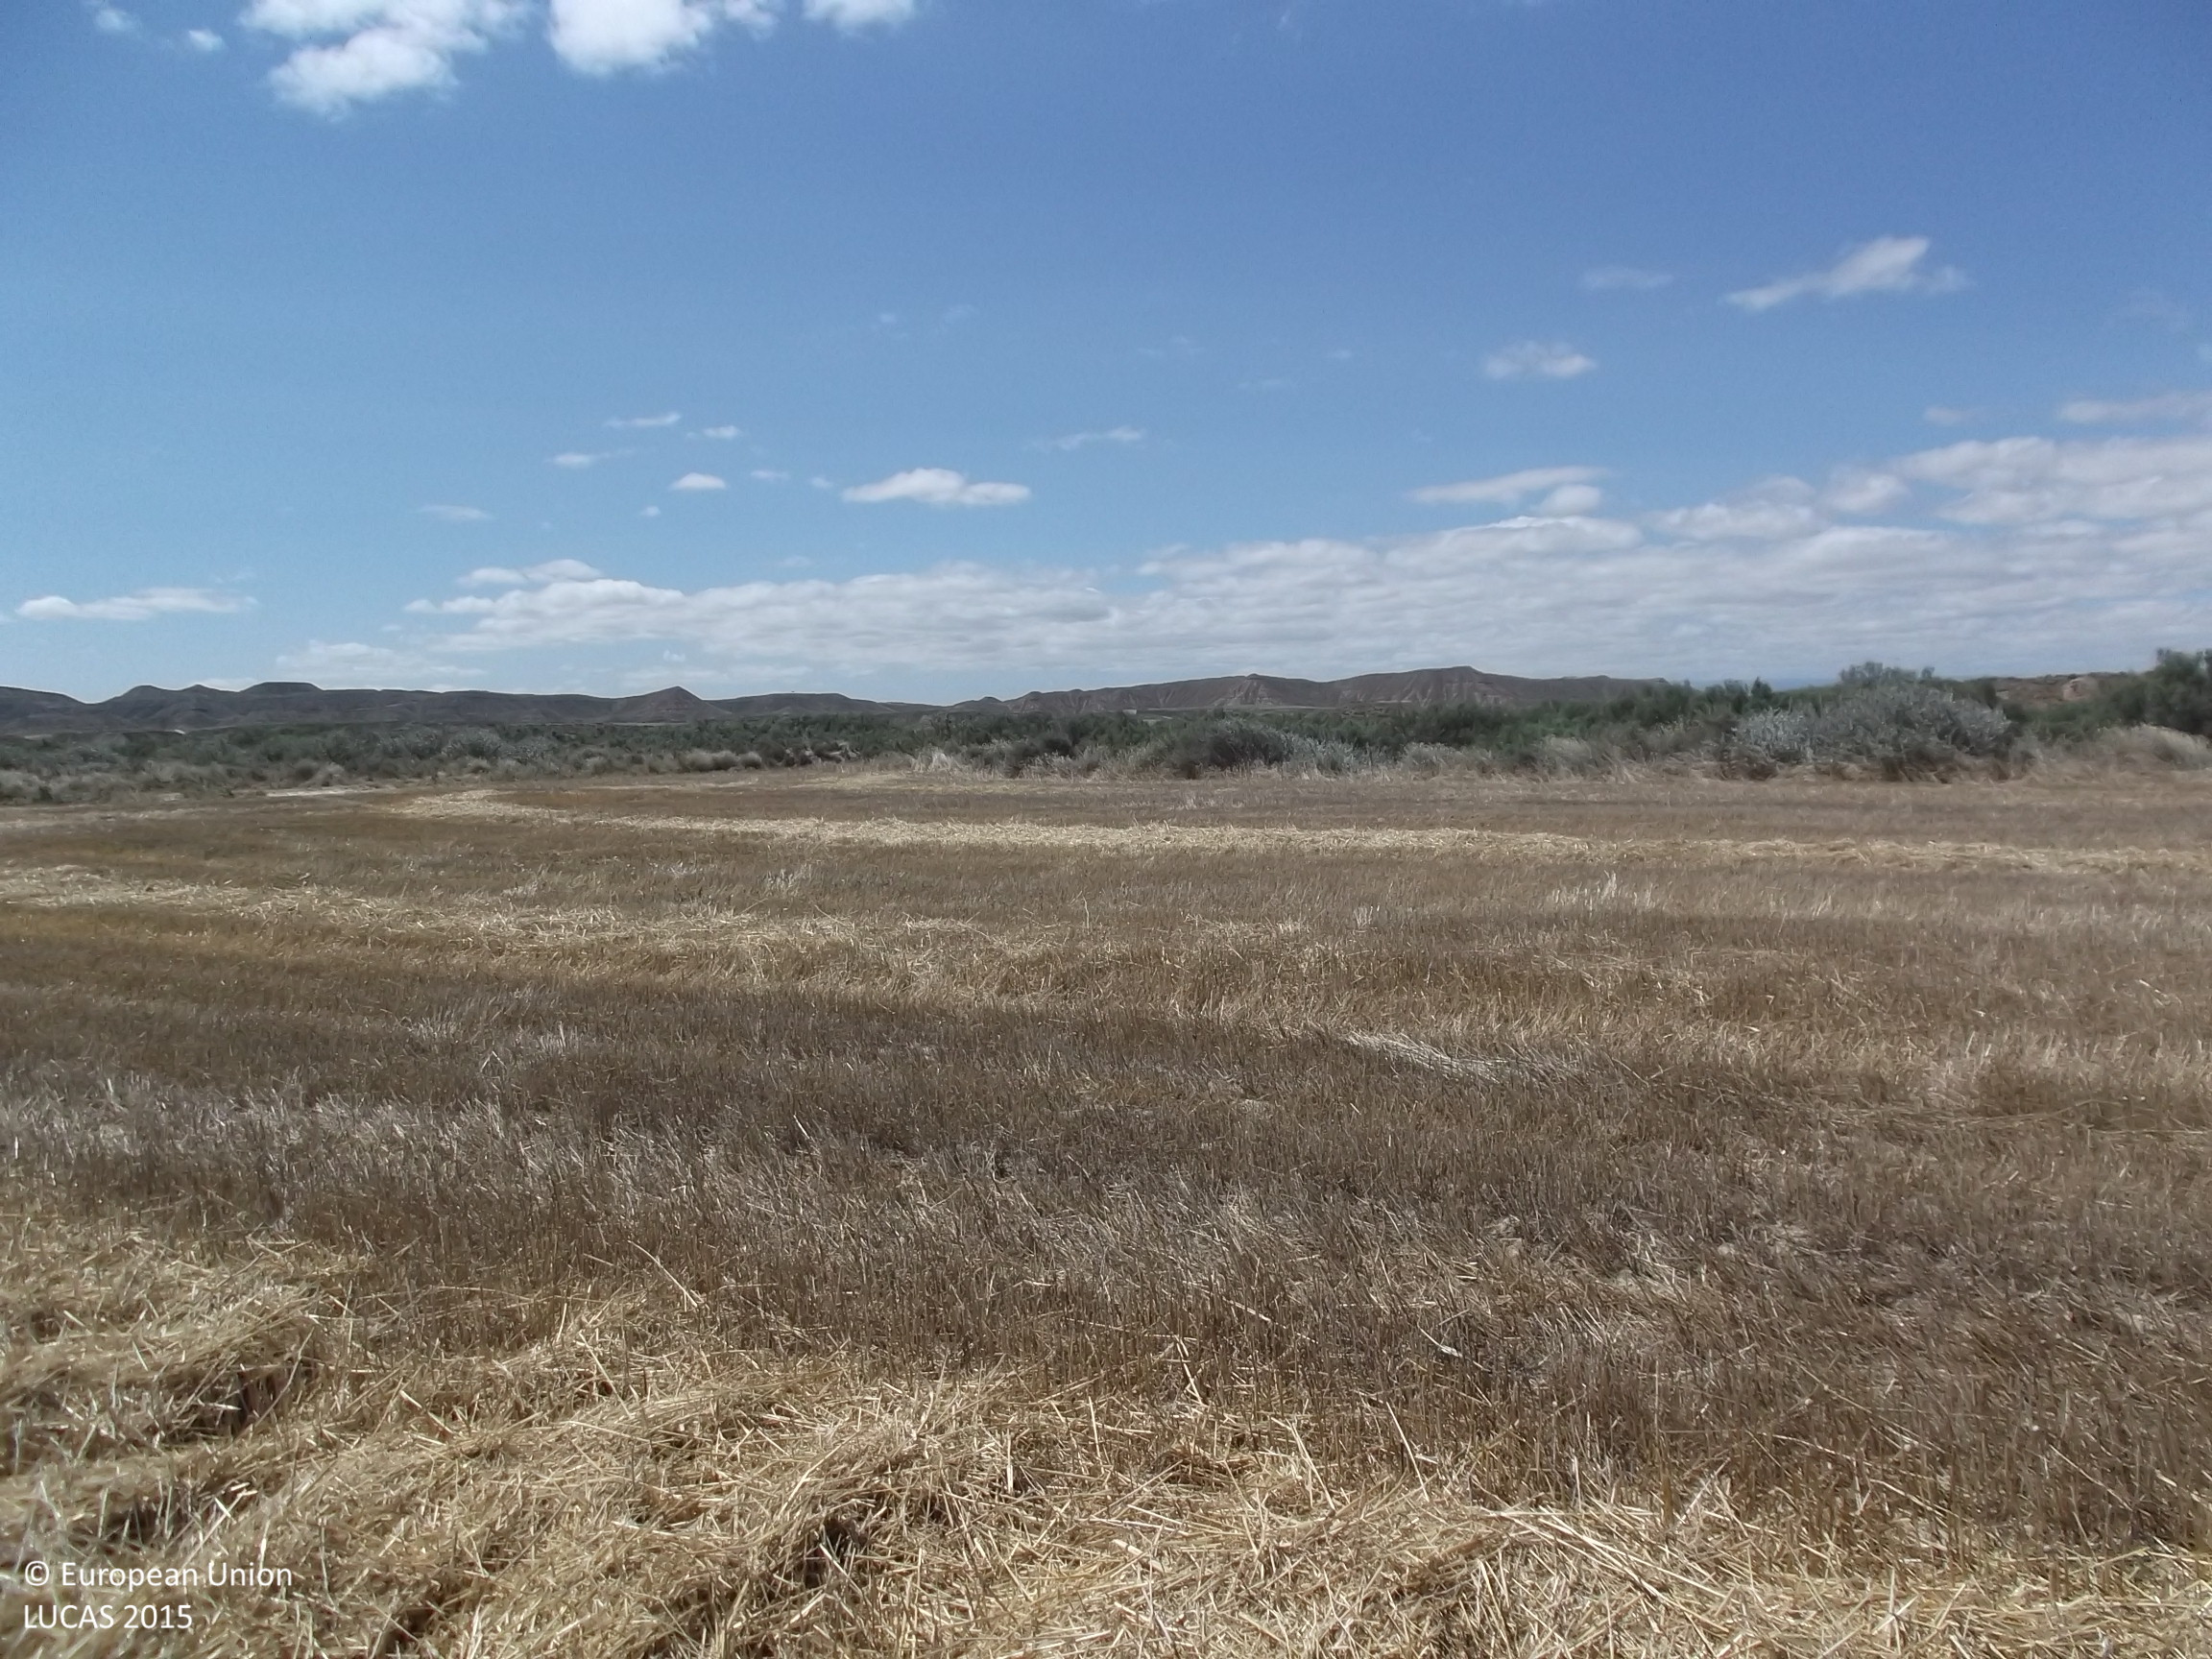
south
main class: Cropland
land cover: Barley
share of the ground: < 10 %
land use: Agriculture (excluding fallow land and kitchen gardens)
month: July
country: ES
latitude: 42.1560
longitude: -1.5415
